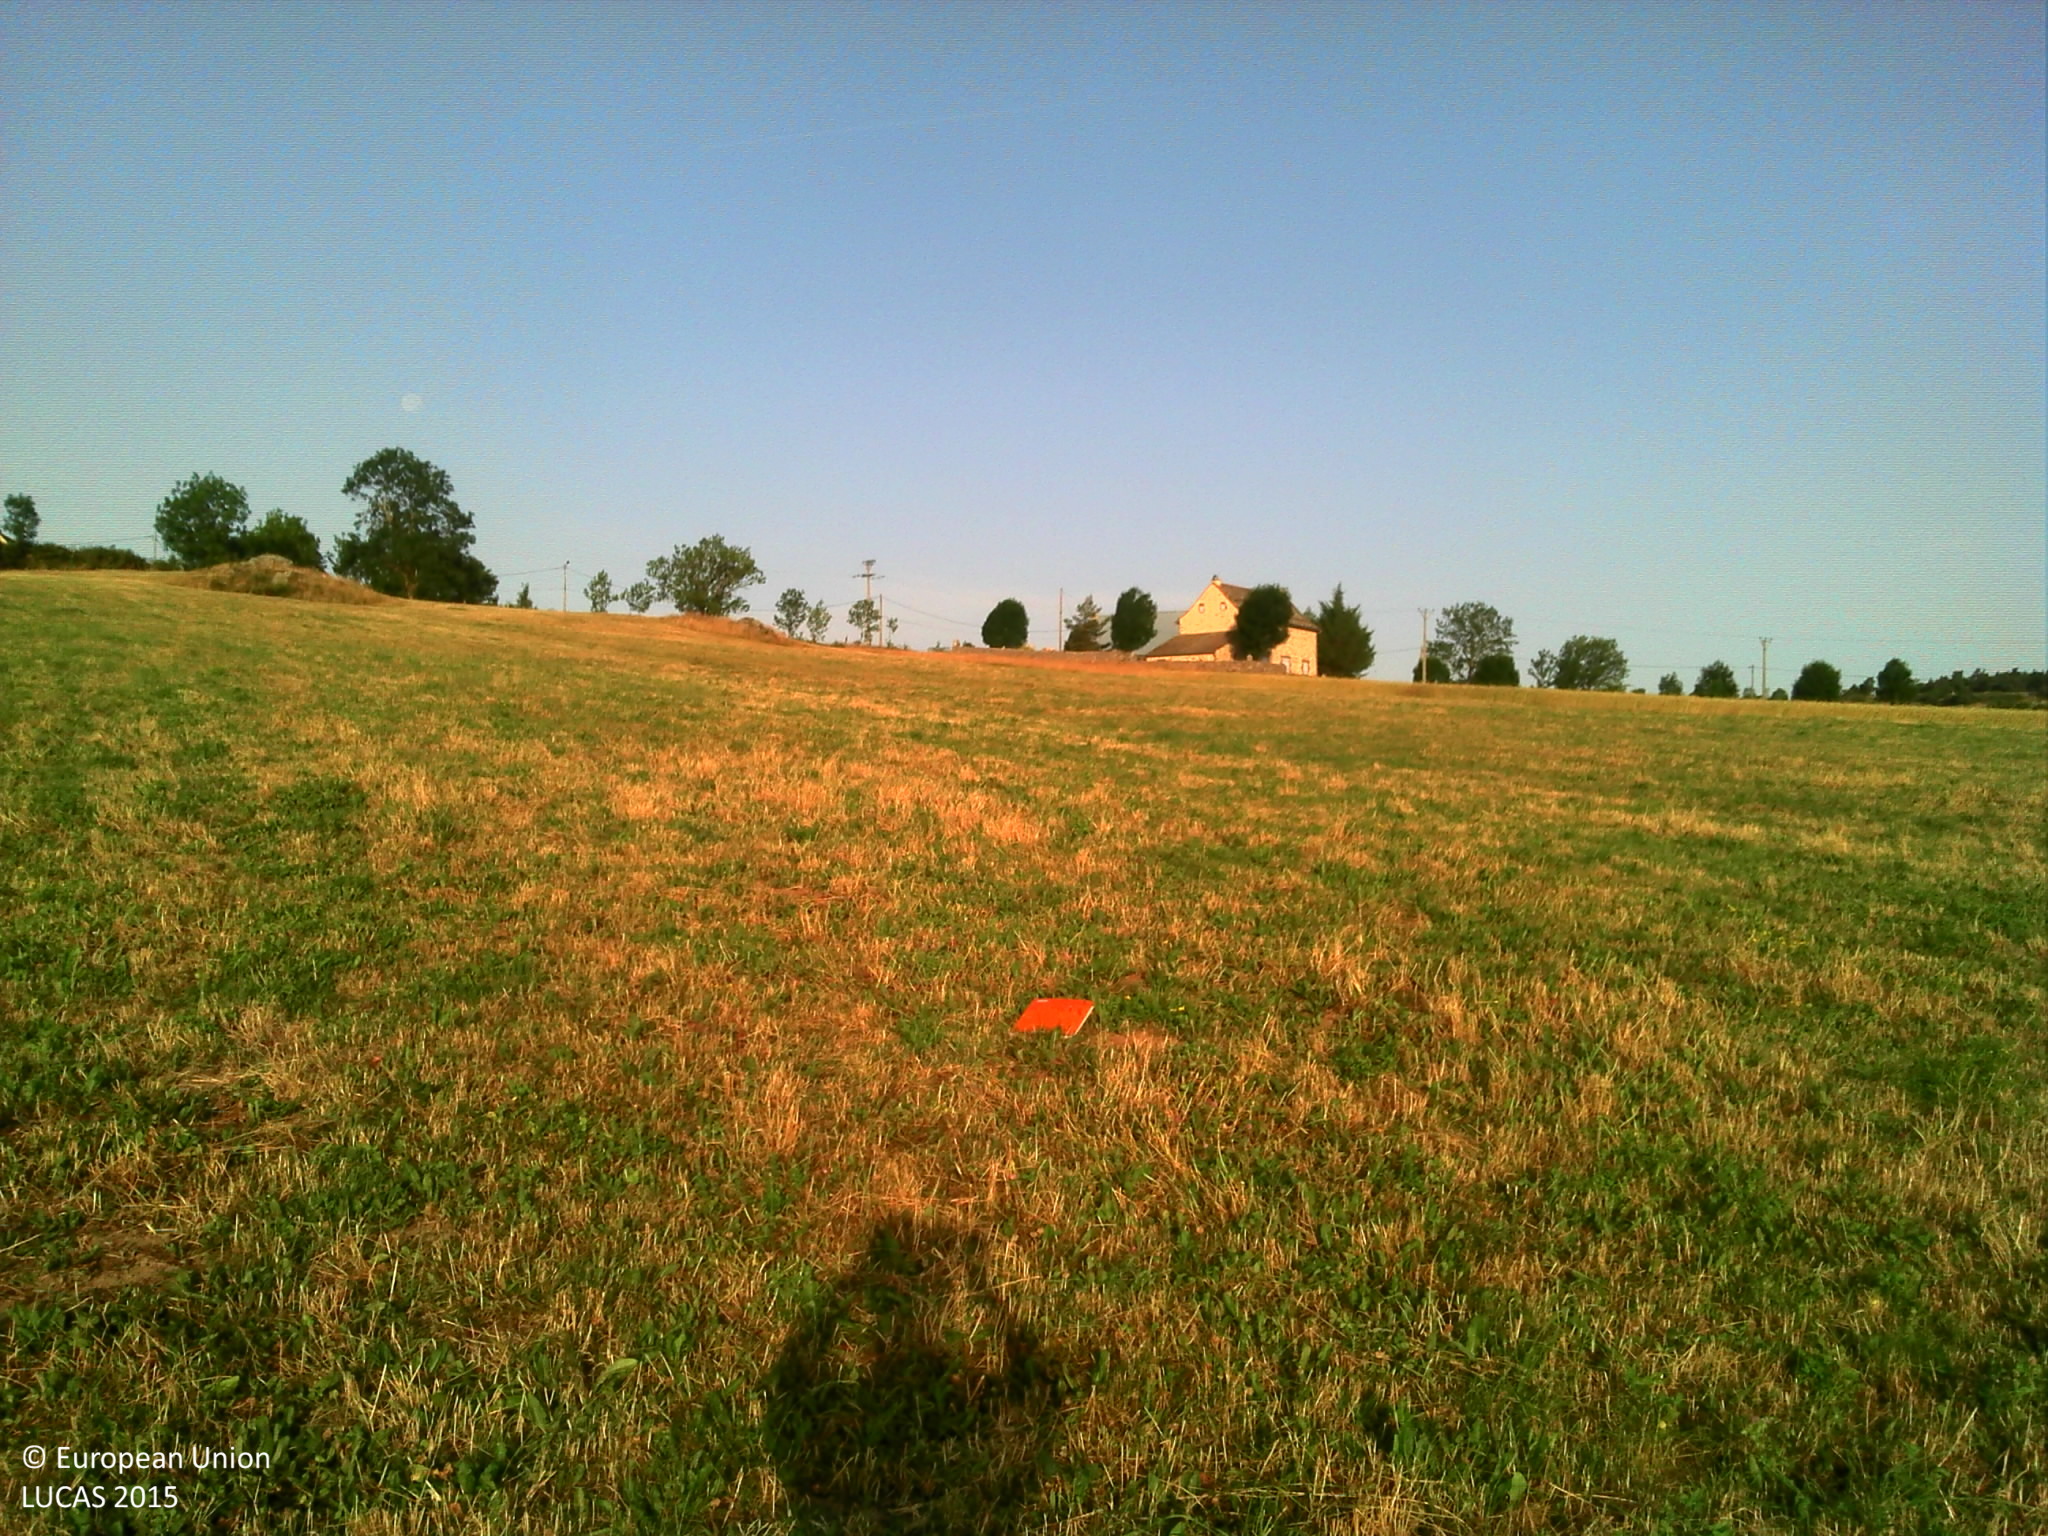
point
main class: Grassland
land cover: Grassland without tree/shrub cover
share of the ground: > 75 %
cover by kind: herbaceous plants 100 %
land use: Agriculture (excluding fallow land and kitchen gardens)
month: July
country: FR
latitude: 45.3327
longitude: 3.0981
